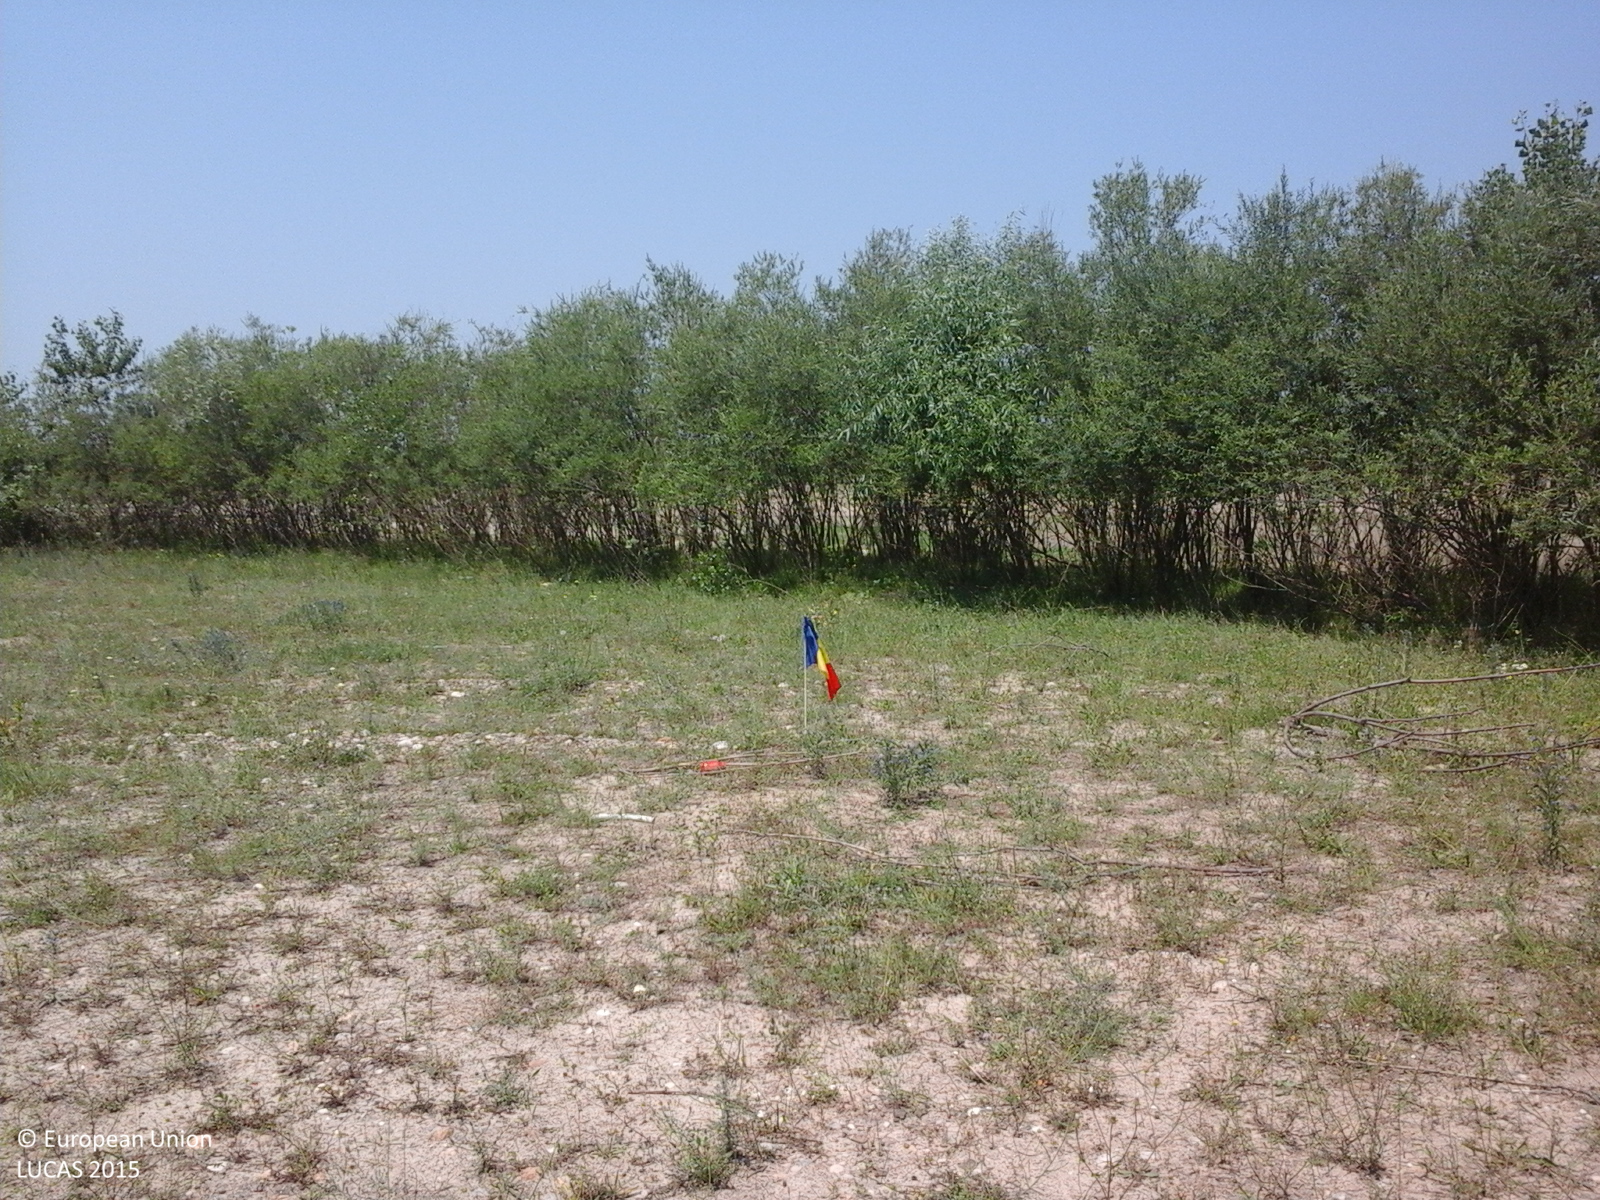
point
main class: Grassland
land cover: Spontaneously vegetated surfaces
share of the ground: 10 - 25 %
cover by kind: herbaceous plants 100 %
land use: Agriculture (excluding fallow land and kitchen gardens)
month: July
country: RO
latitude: 44.7921
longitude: 25.7359
